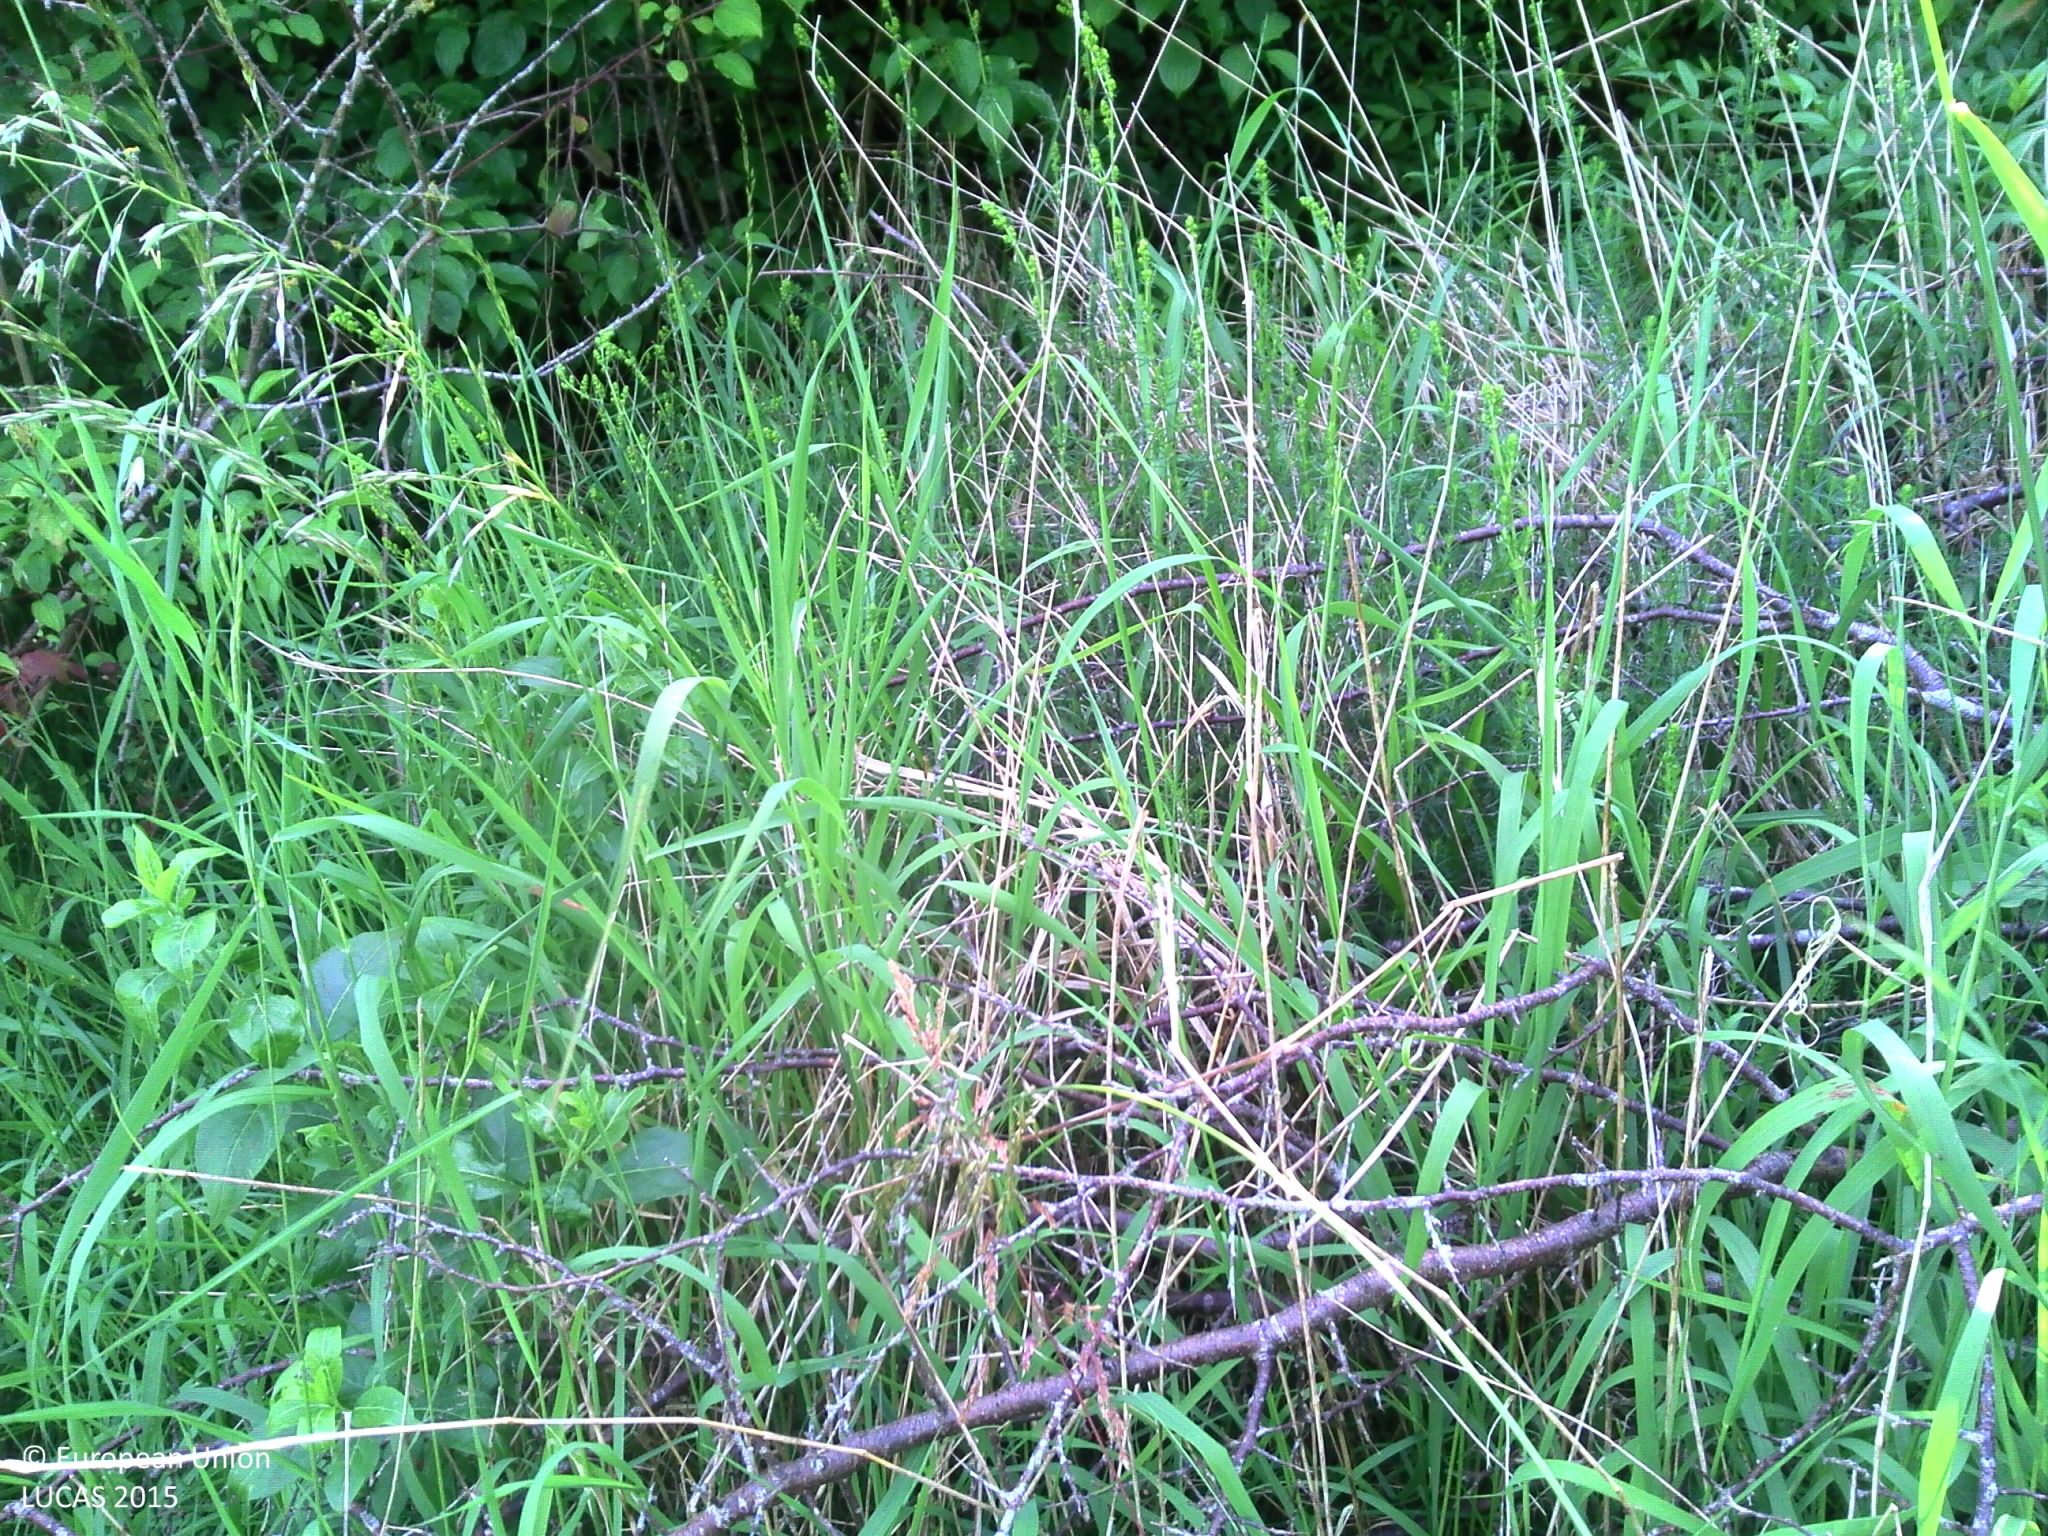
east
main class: Woodland
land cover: Broadleaved woodland
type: non-riverine alder, birch or aspen forest
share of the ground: > 75 %
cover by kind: broadleaved forest trees 80 %, shrubs 10 %, herbaceous plants 5 %, lichens and mosses 5 %
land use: Forestry
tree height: > 5 m
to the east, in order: Broadleaved woodland; Rape and turnip rape; Grass margins
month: June
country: FR
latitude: 49.7193
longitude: 2.4839
